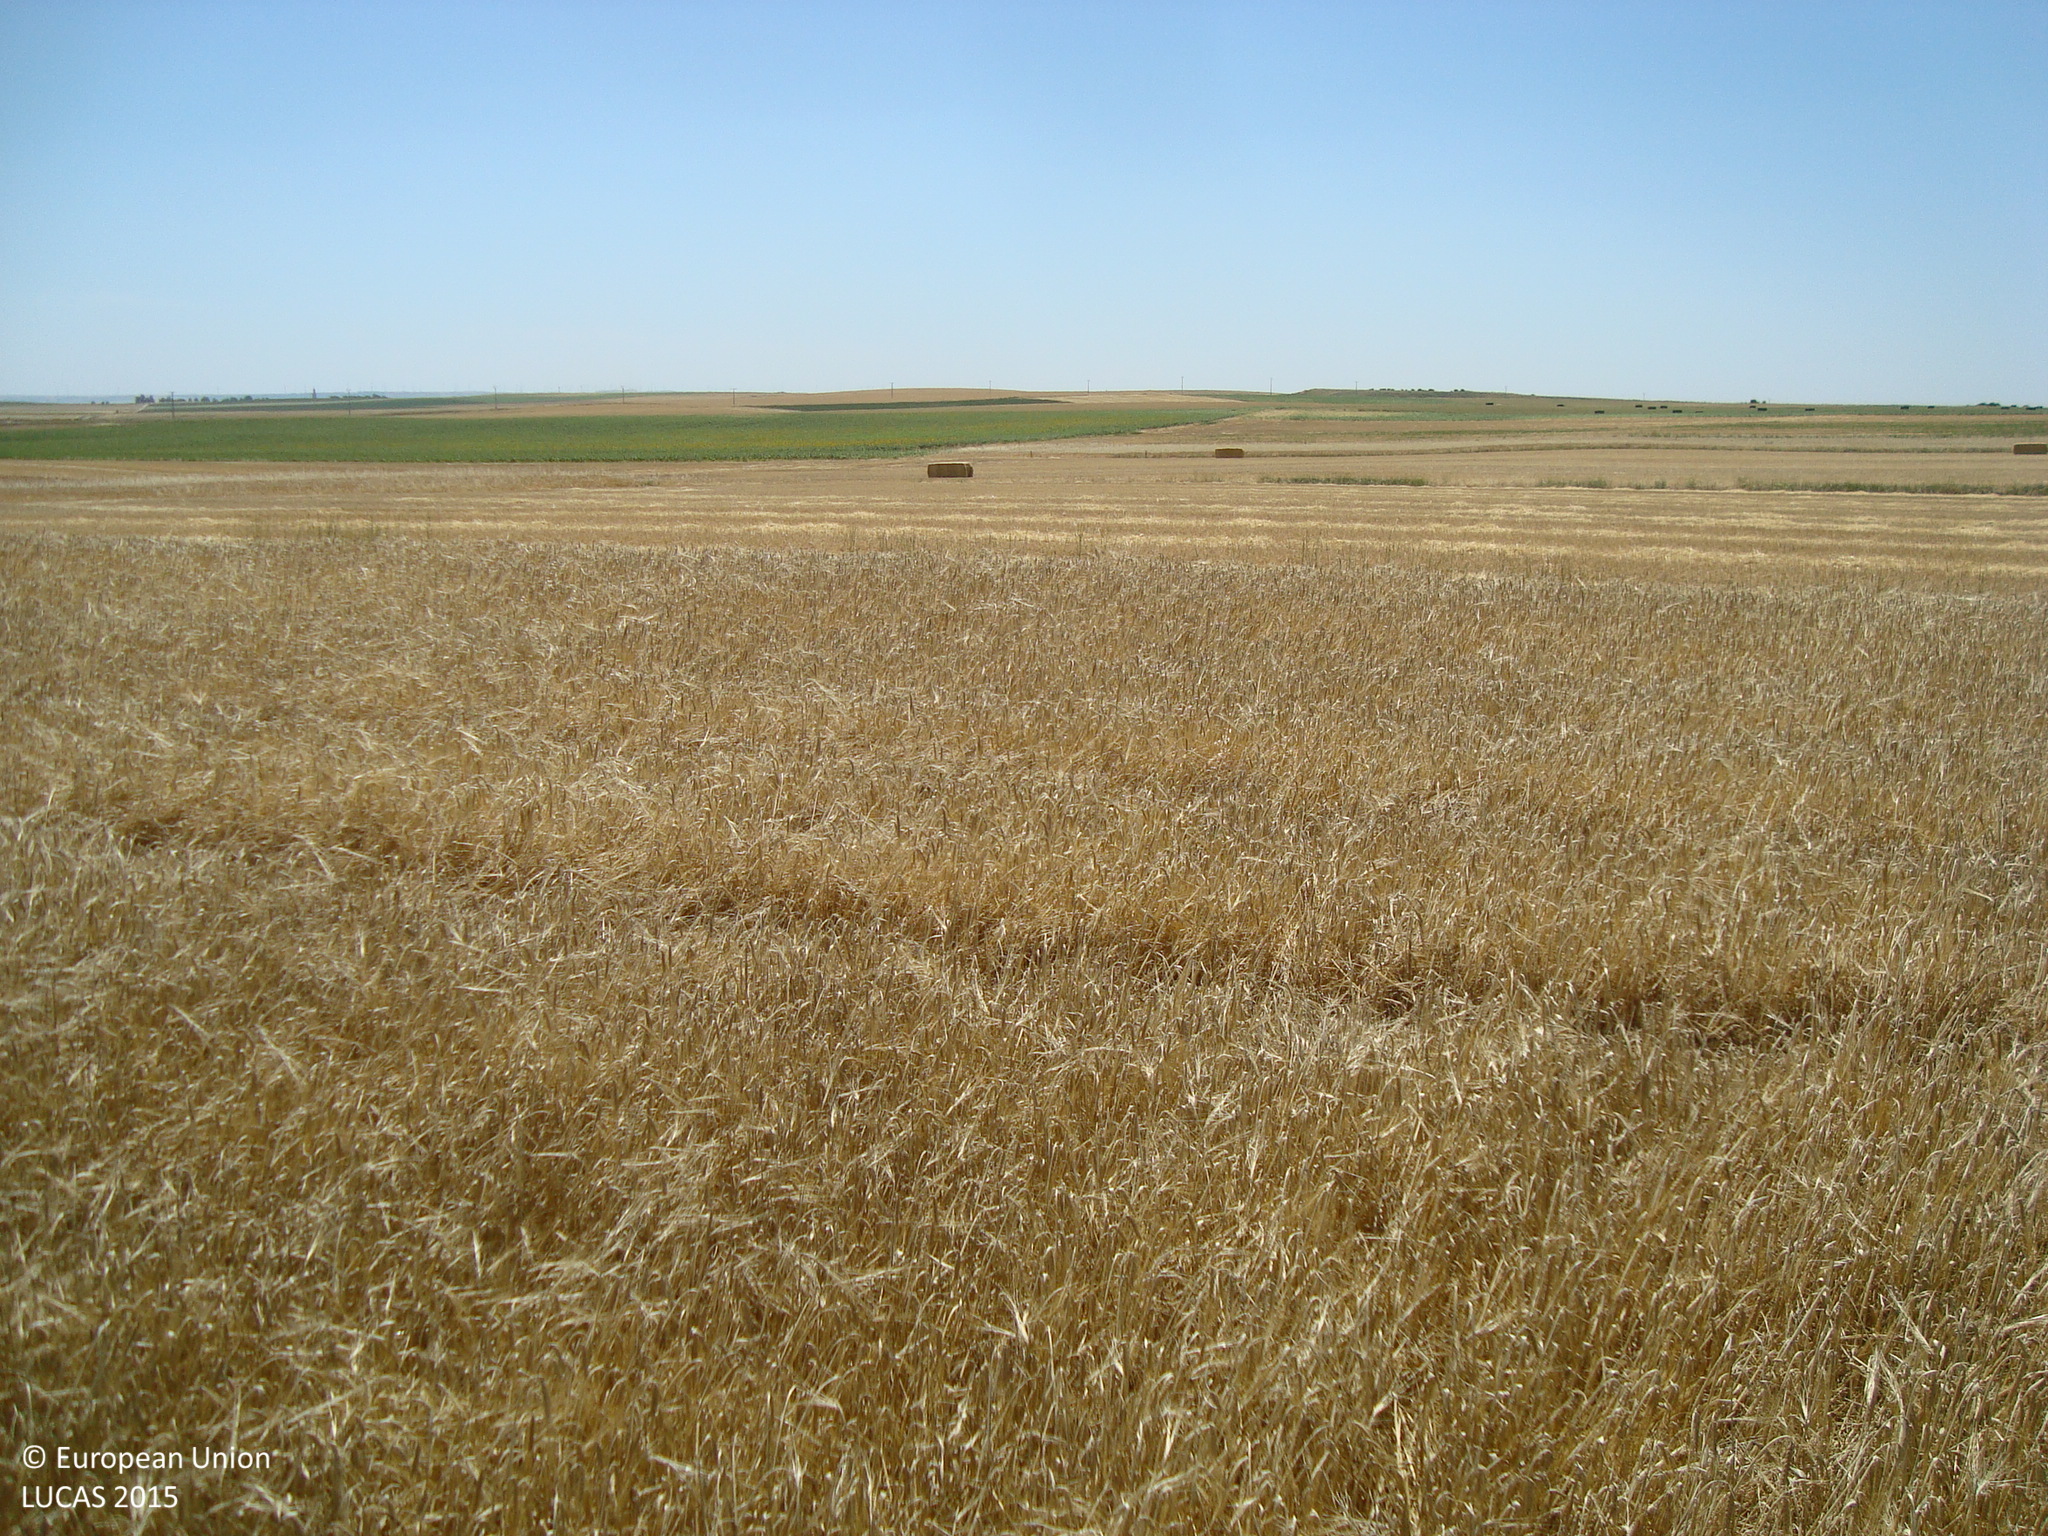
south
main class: Cropland
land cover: Barley
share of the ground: > 75 %
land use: Agriculture (excluding fallow land and kitchen gardens)
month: July
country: ES
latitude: 42.1283
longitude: -4.7985
